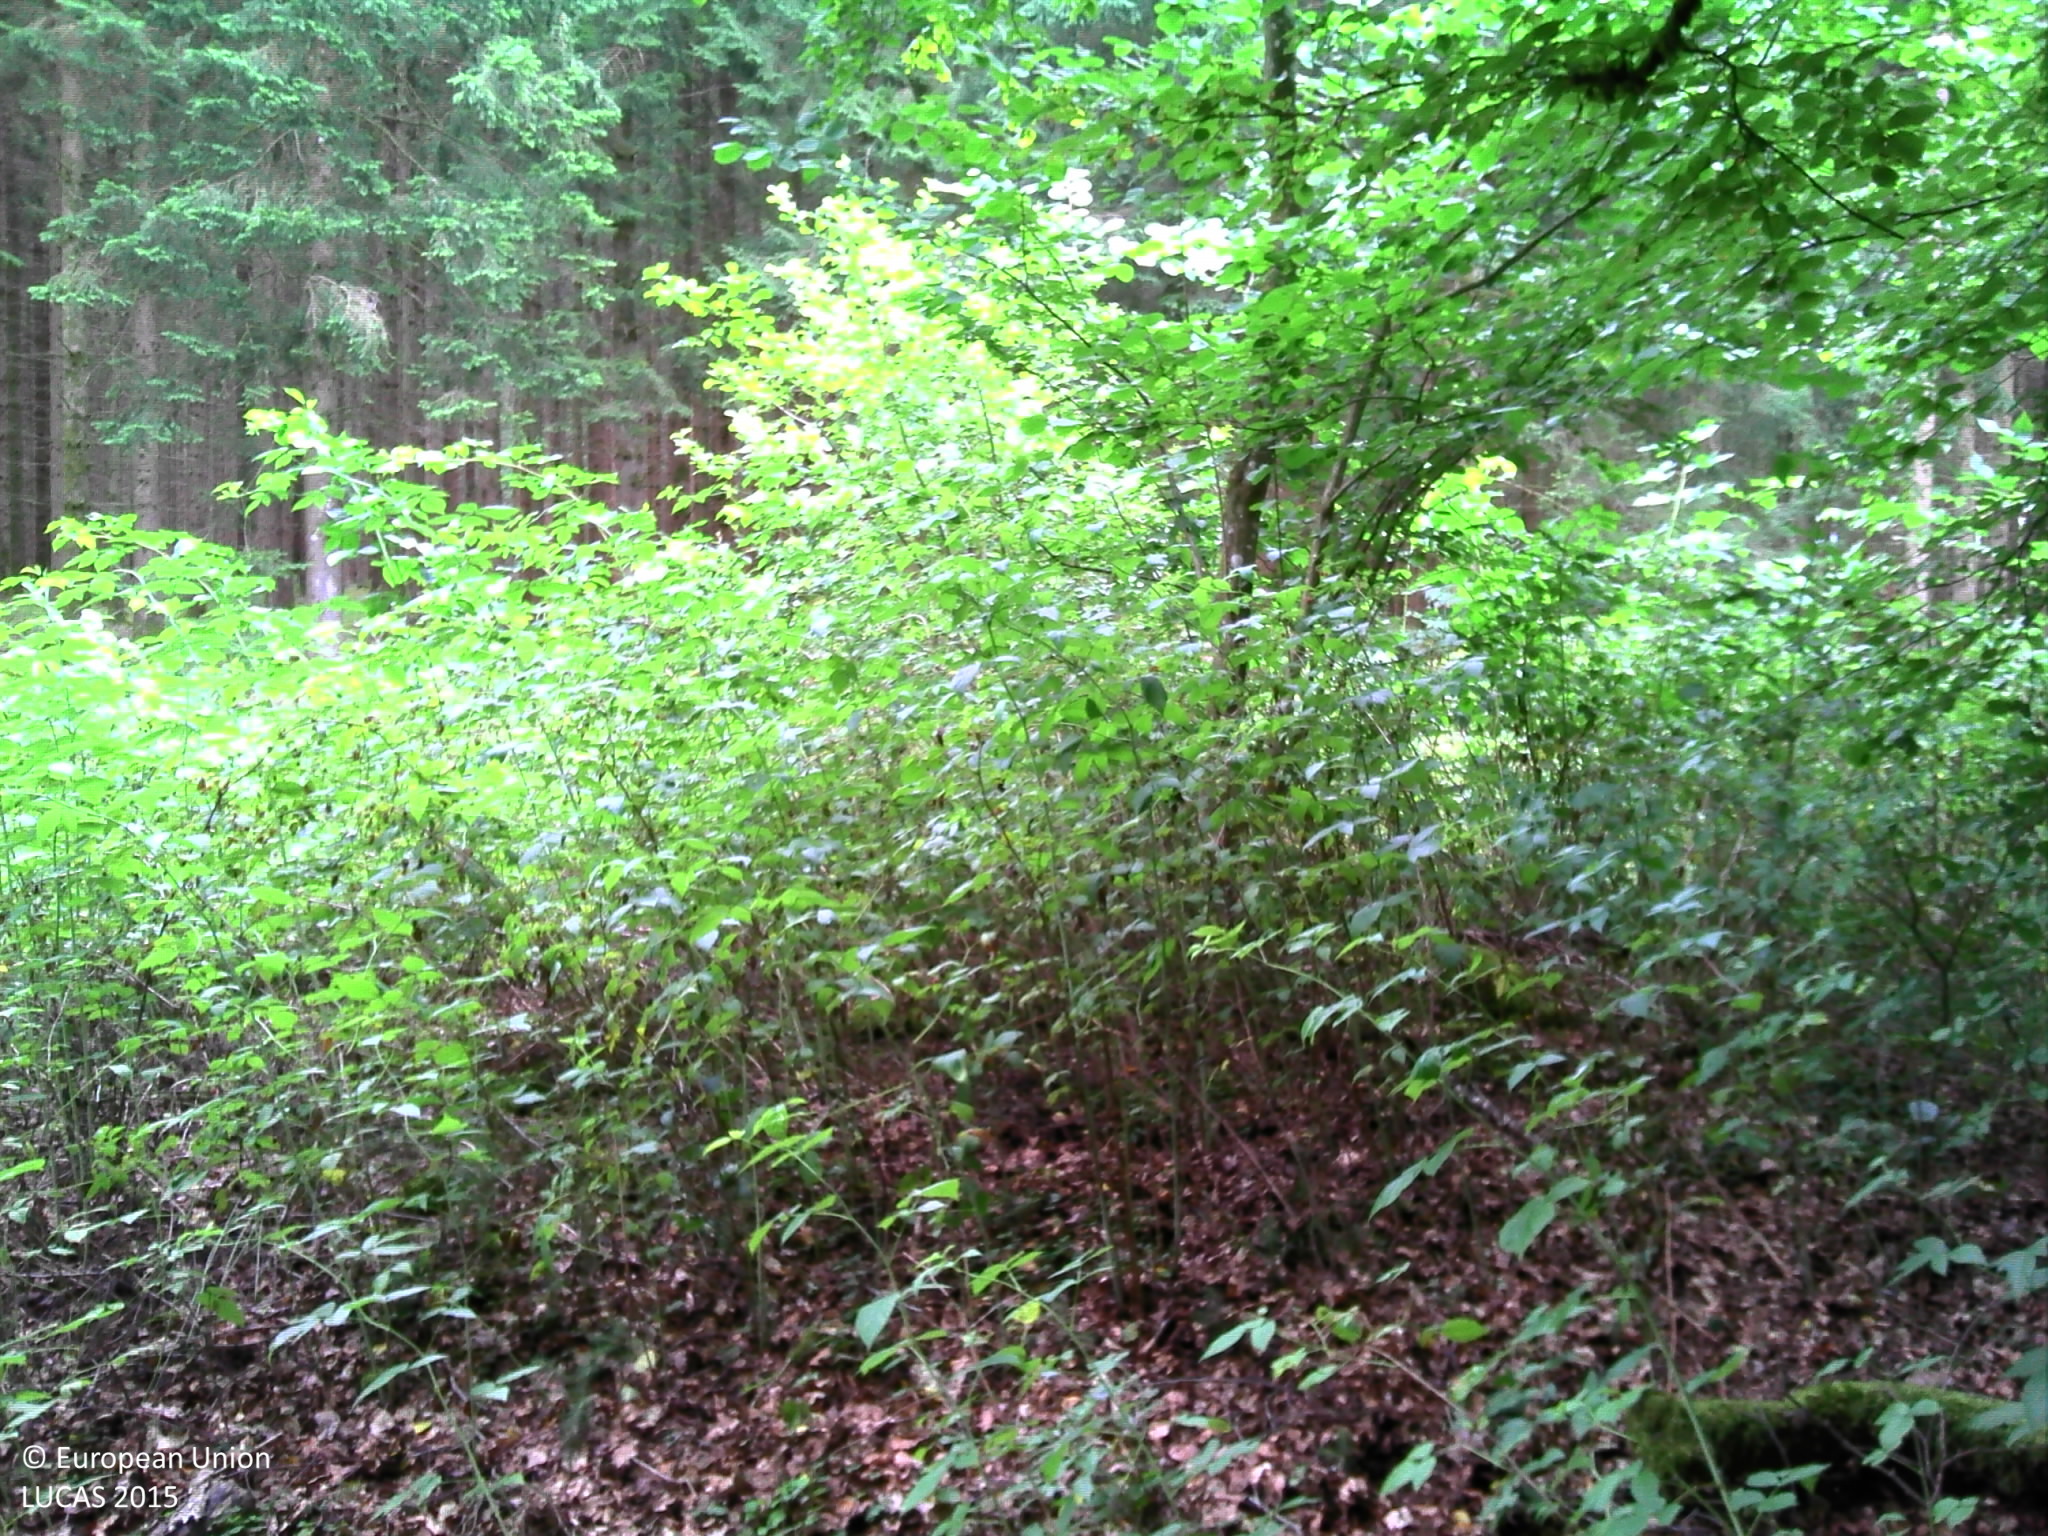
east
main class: Woodland
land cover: Broadleaved woodland
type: acidophilous oak and oak-birch forest
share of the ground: > 75 %
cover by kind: broadleaved forest trees 80 %, shrubs 10 %, herbaceous plants 10 %
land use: Forestry
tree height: > 5 m
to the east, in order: Broadleaved woodland; Spontaneously vegetated surfaces; Tracks; Grass margins; Spruce dominated coniferous woodland; Tracks; Spruce dominated coniferous woodland; Tracks; Spruce dominated coniferous woodland
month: July
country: BE
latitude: 49.6505
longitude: 5.6357
